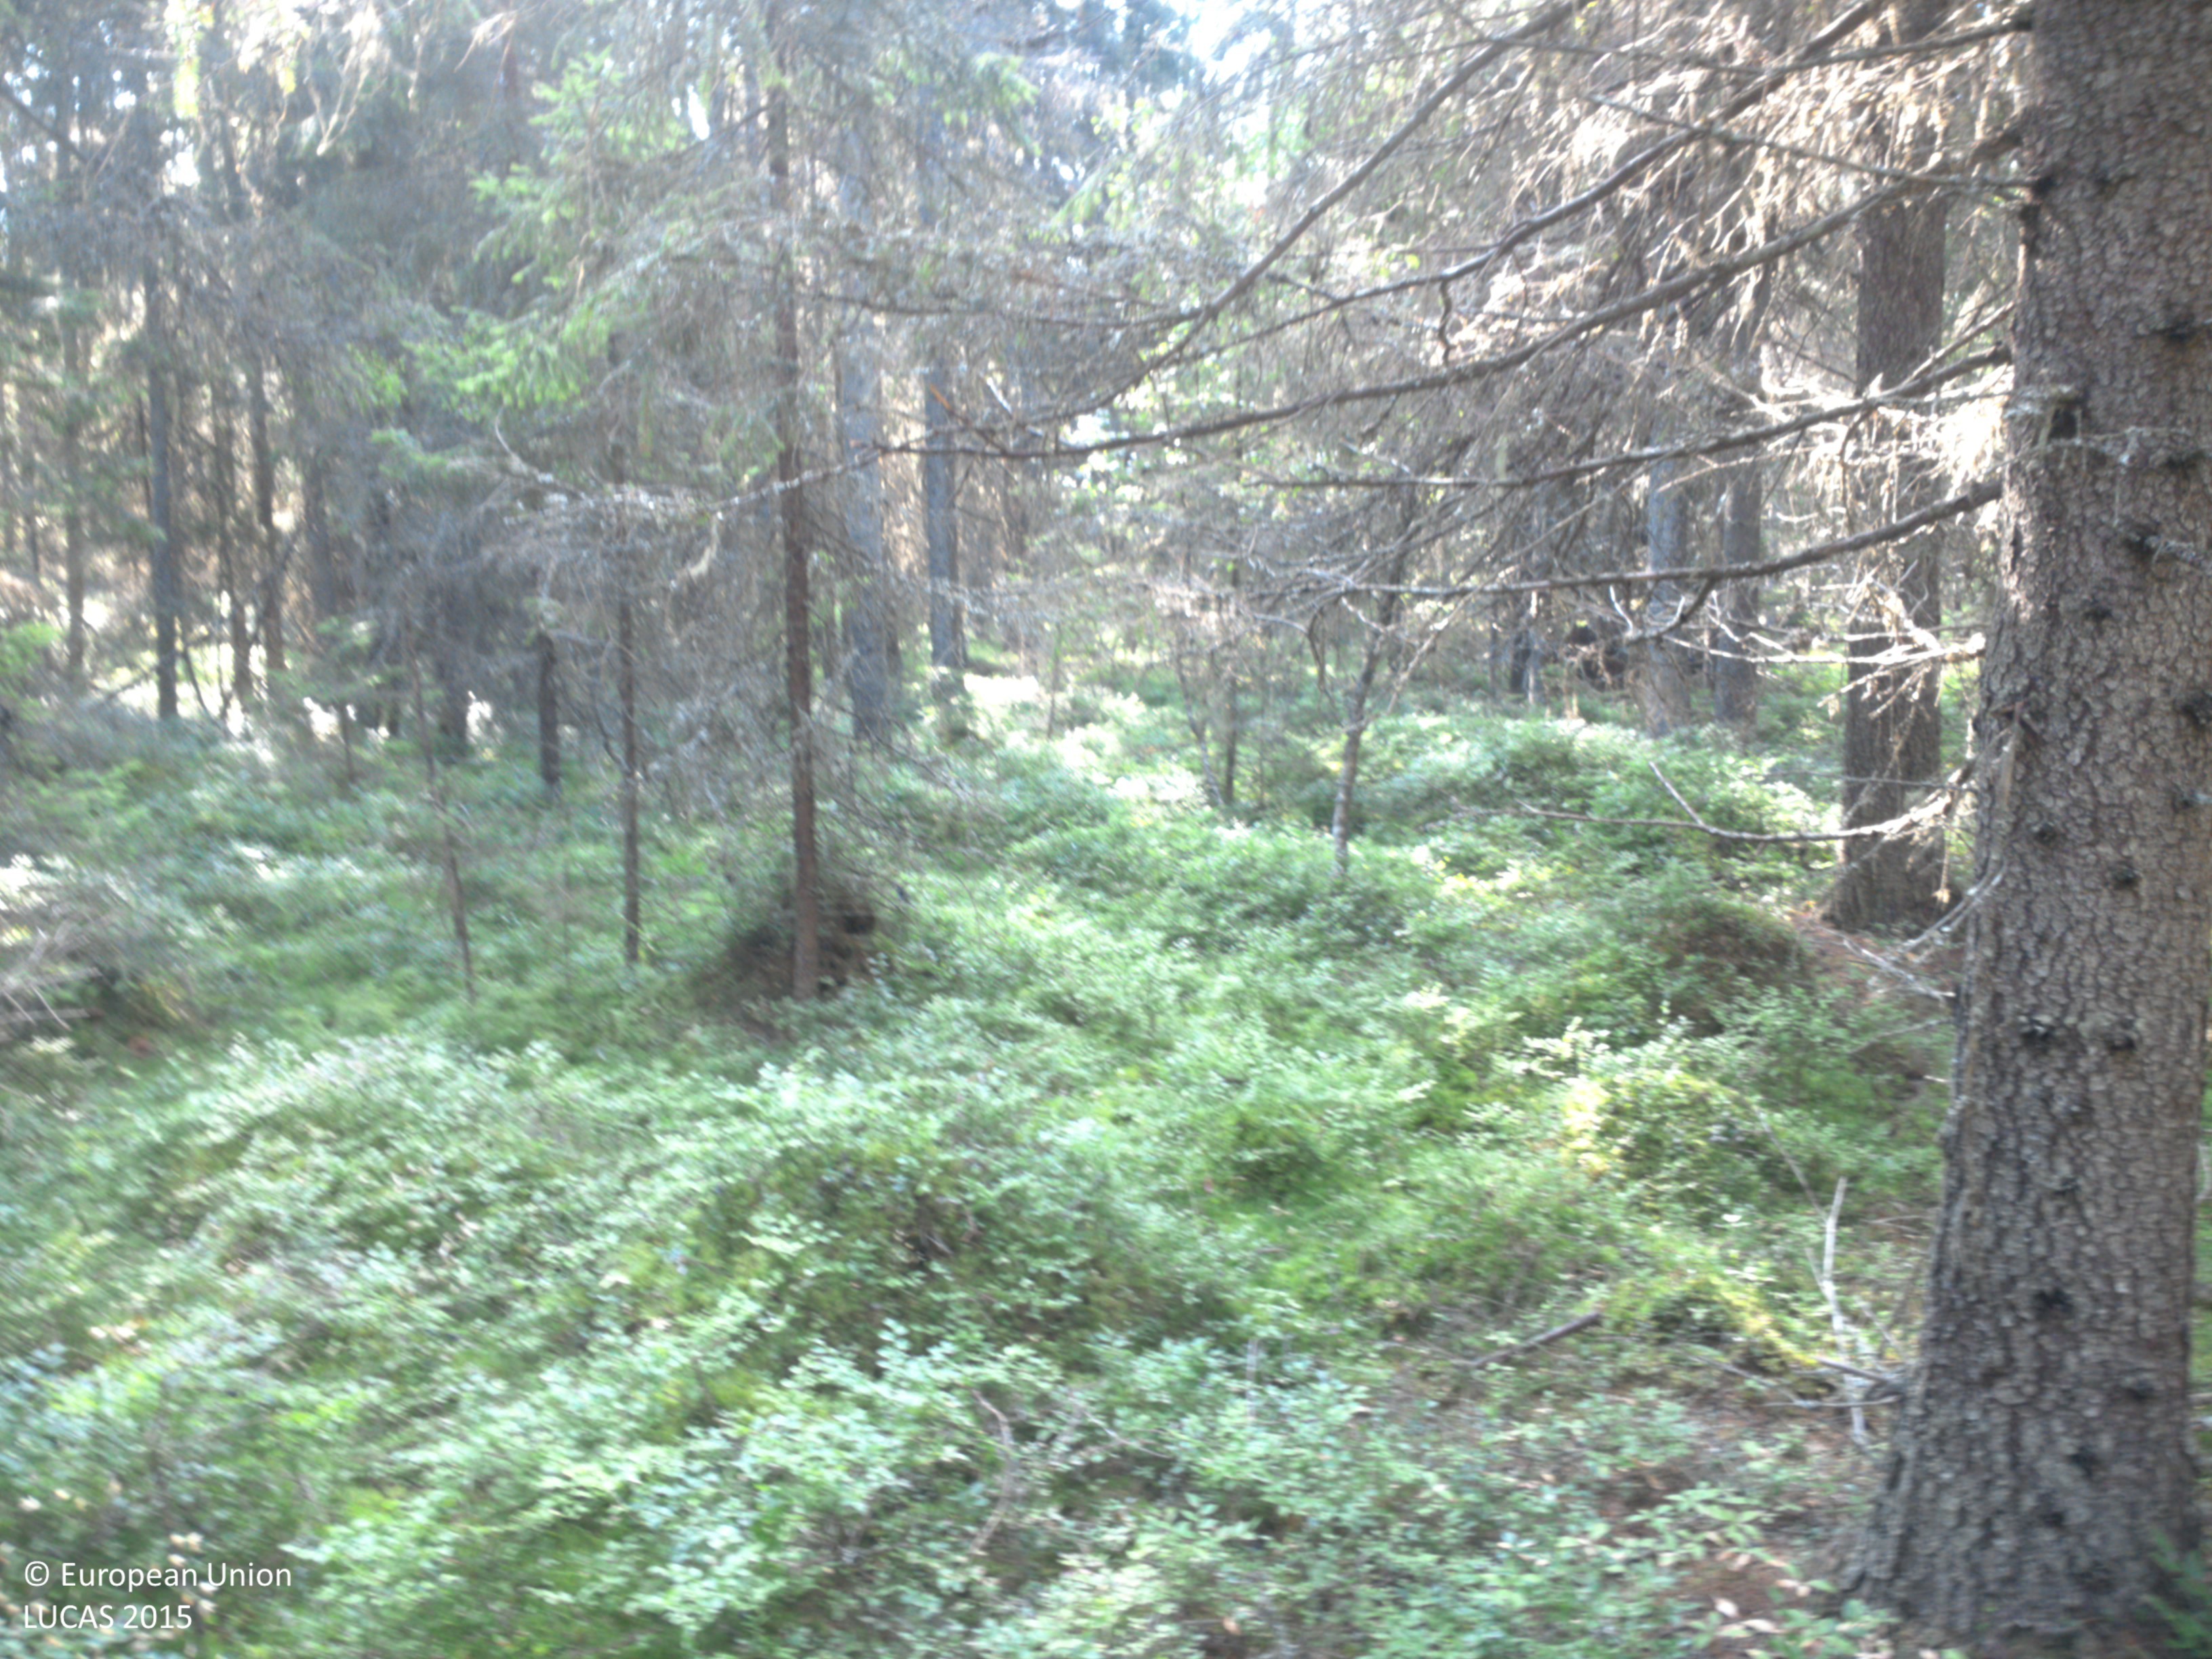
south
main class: Woodland
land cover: Spruce dominated coniferous woodland
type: boreal forest
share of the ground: 50 - 75 %
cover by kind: coniferous forest trees 60 %, shrubs 40 %
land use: Forestry
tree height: > 5 m
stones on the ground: < 10 %
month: August
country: SE
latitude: 63.5057
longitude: 19.6046
